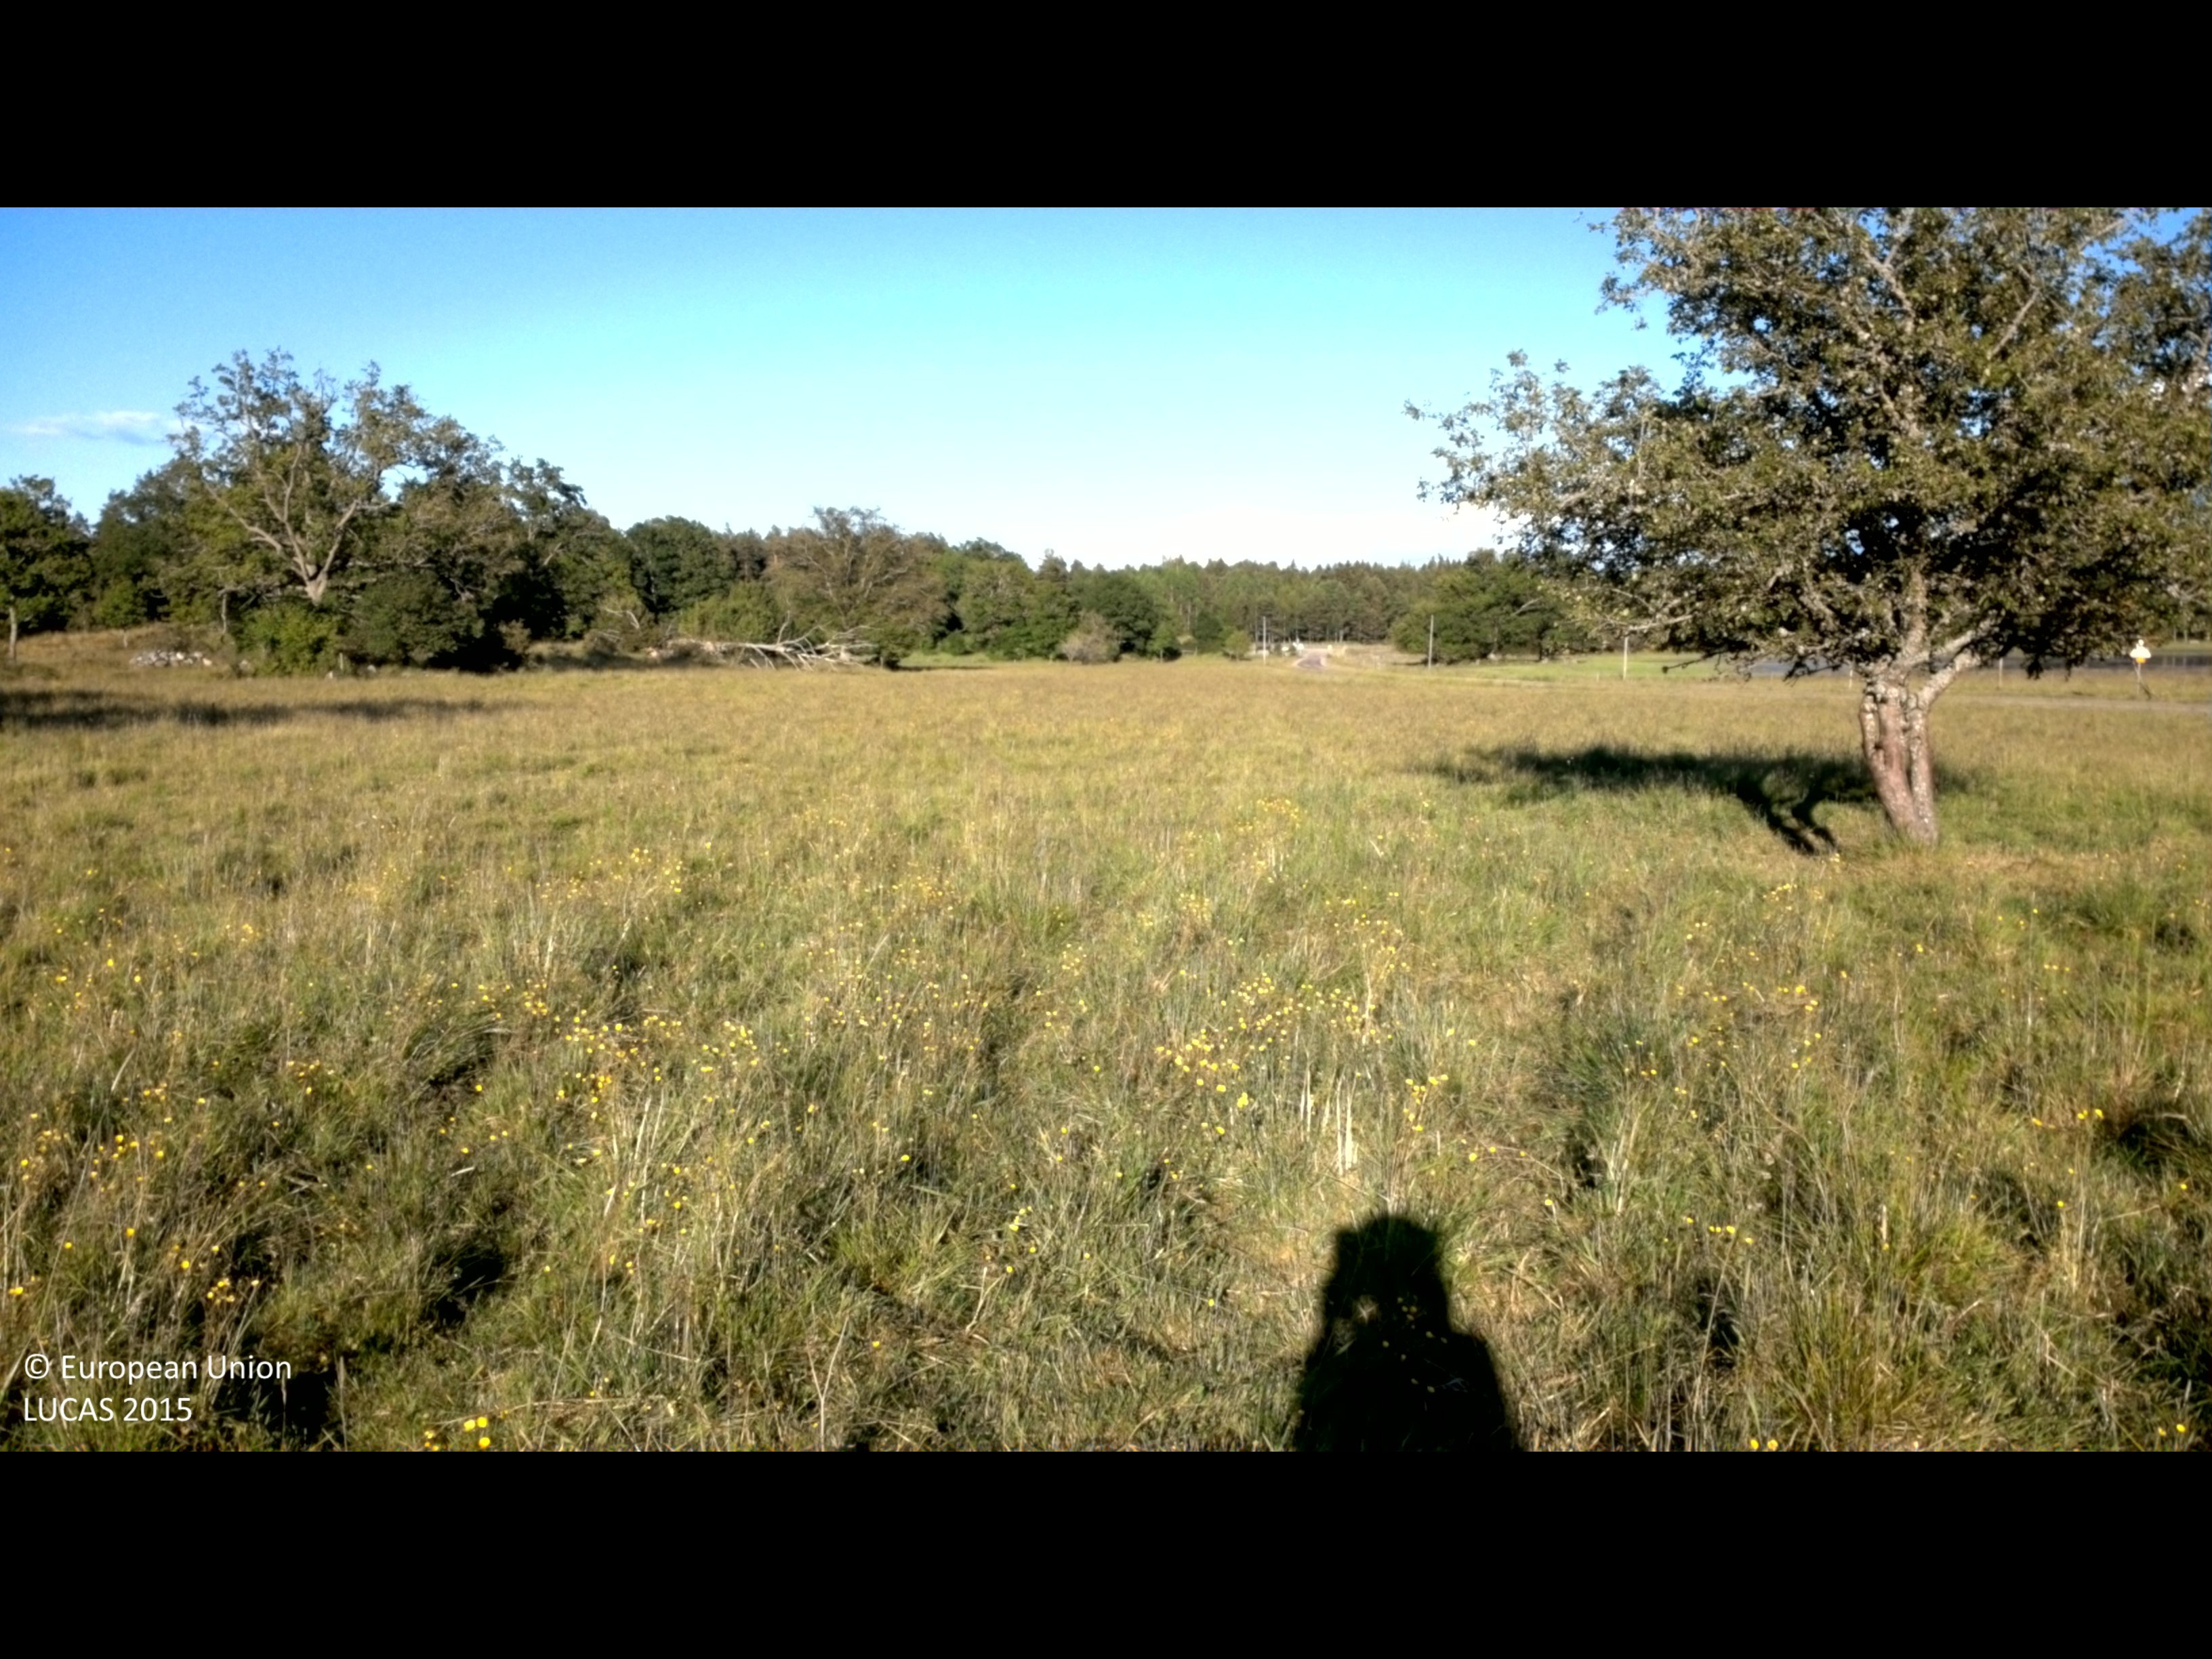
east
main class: Grassland
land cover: Grassland with sparse tree/shrub cover
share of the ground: > 75 %
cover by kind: herbaceous plants 95 %, broadleaved forest trees 5 %
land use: Agriculture (excluding fallow land and kitchen gardens)
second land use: Amenities, museums, leisure
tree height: > 5 m
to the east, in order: Grassland with sparse tree/shrub cover; Grassland without tree/shrub cover; Grassland with sparse tree/shrub cover; Ditches and canals; Broadleaved woodland; Ditches and canals; Grassland without tree/shrub cover
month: June
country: SE
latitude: 58.3726
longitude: 15.6197
